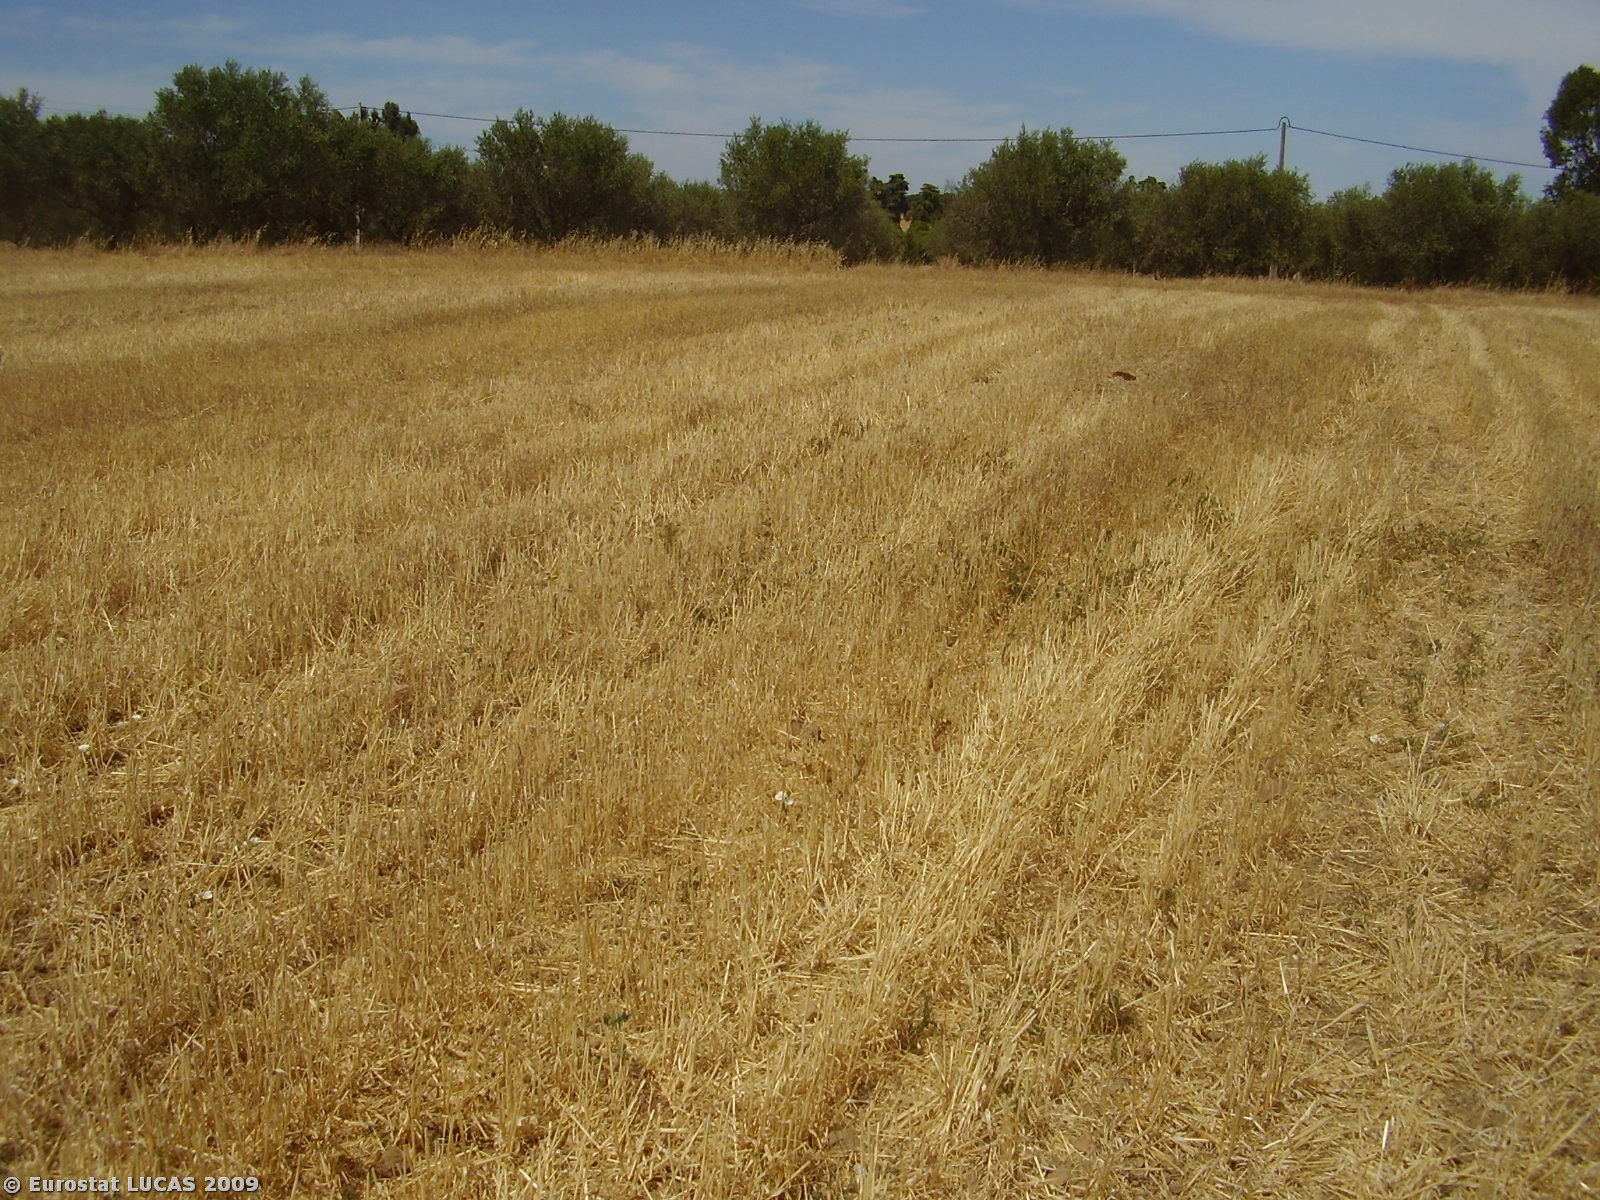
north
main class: Cropland
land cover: Common wheat
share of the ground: > 75 %
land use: Agriculture (excluding fallow land and kitchen gardens)
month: August
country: PT
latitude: 38.0622
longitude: -7.8426
